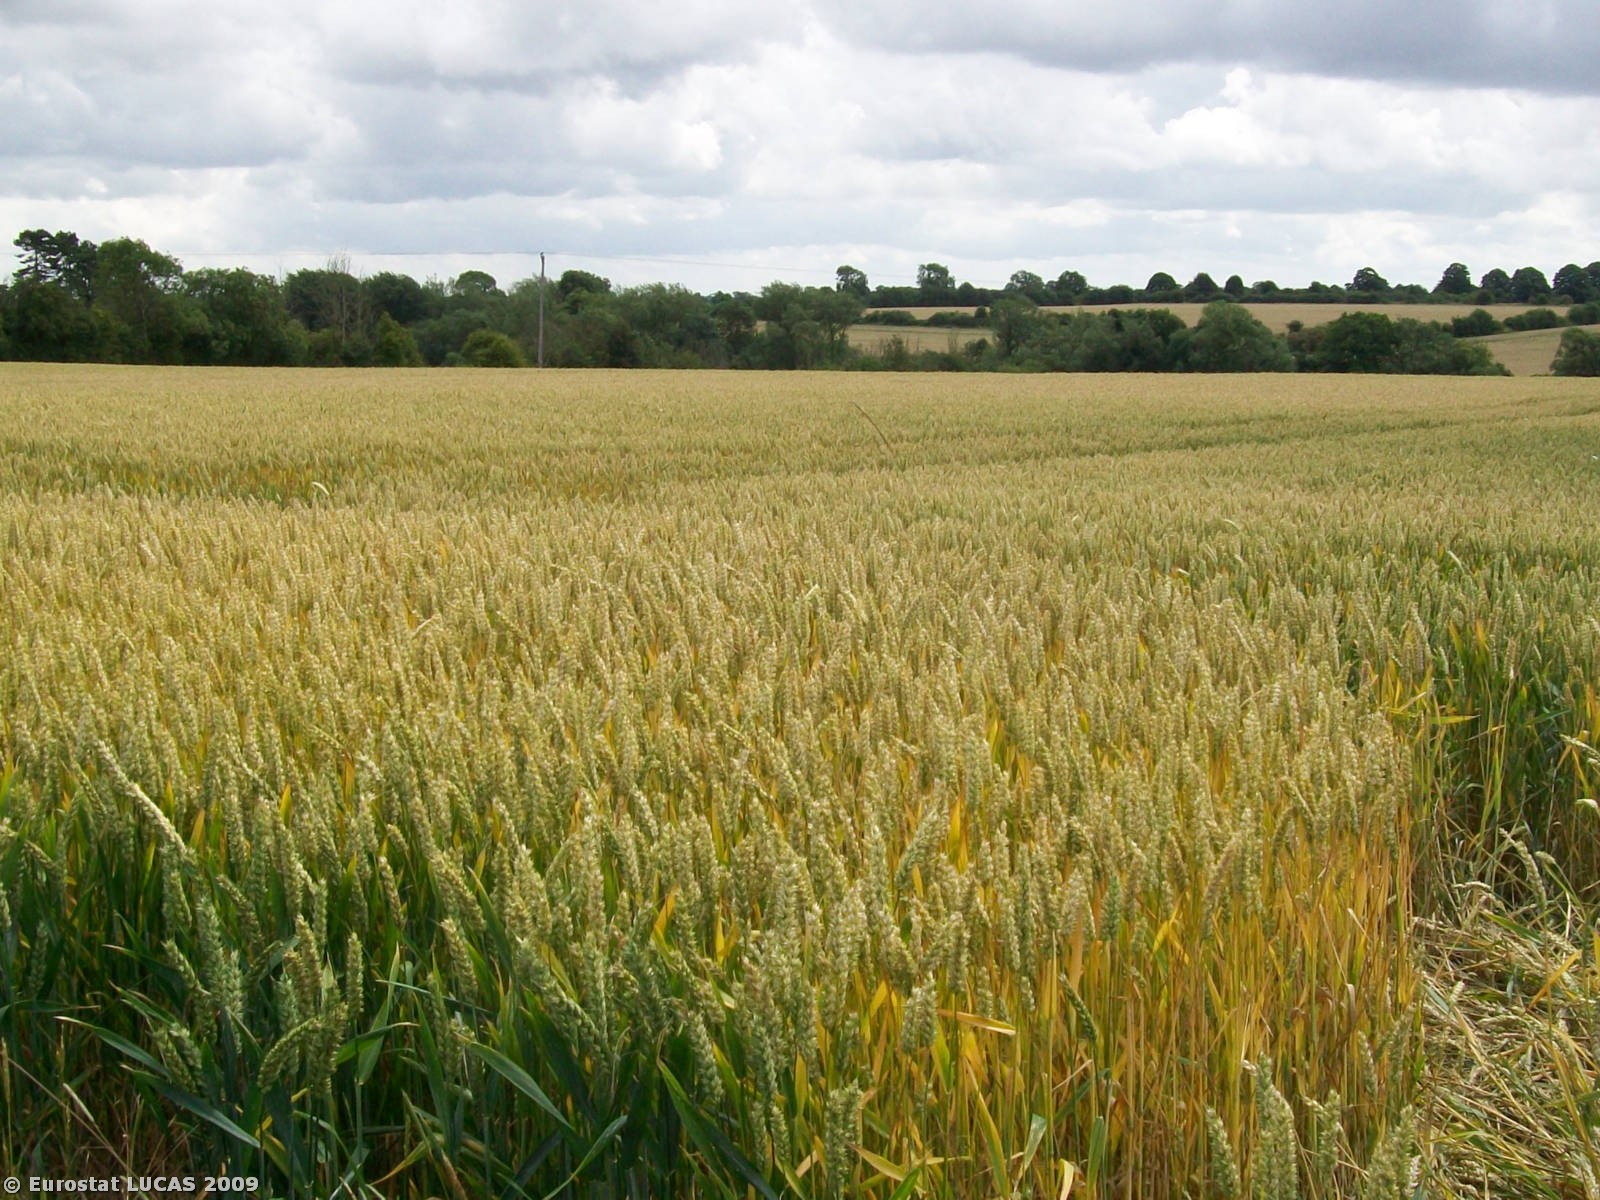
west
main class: Cropland
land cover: Rape and turnip rape
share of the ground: > 75 %
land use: Agriculture (excluding fallow land and kitchen gardens)
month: July
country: GB
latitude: 52.0275
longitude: -1.1967
